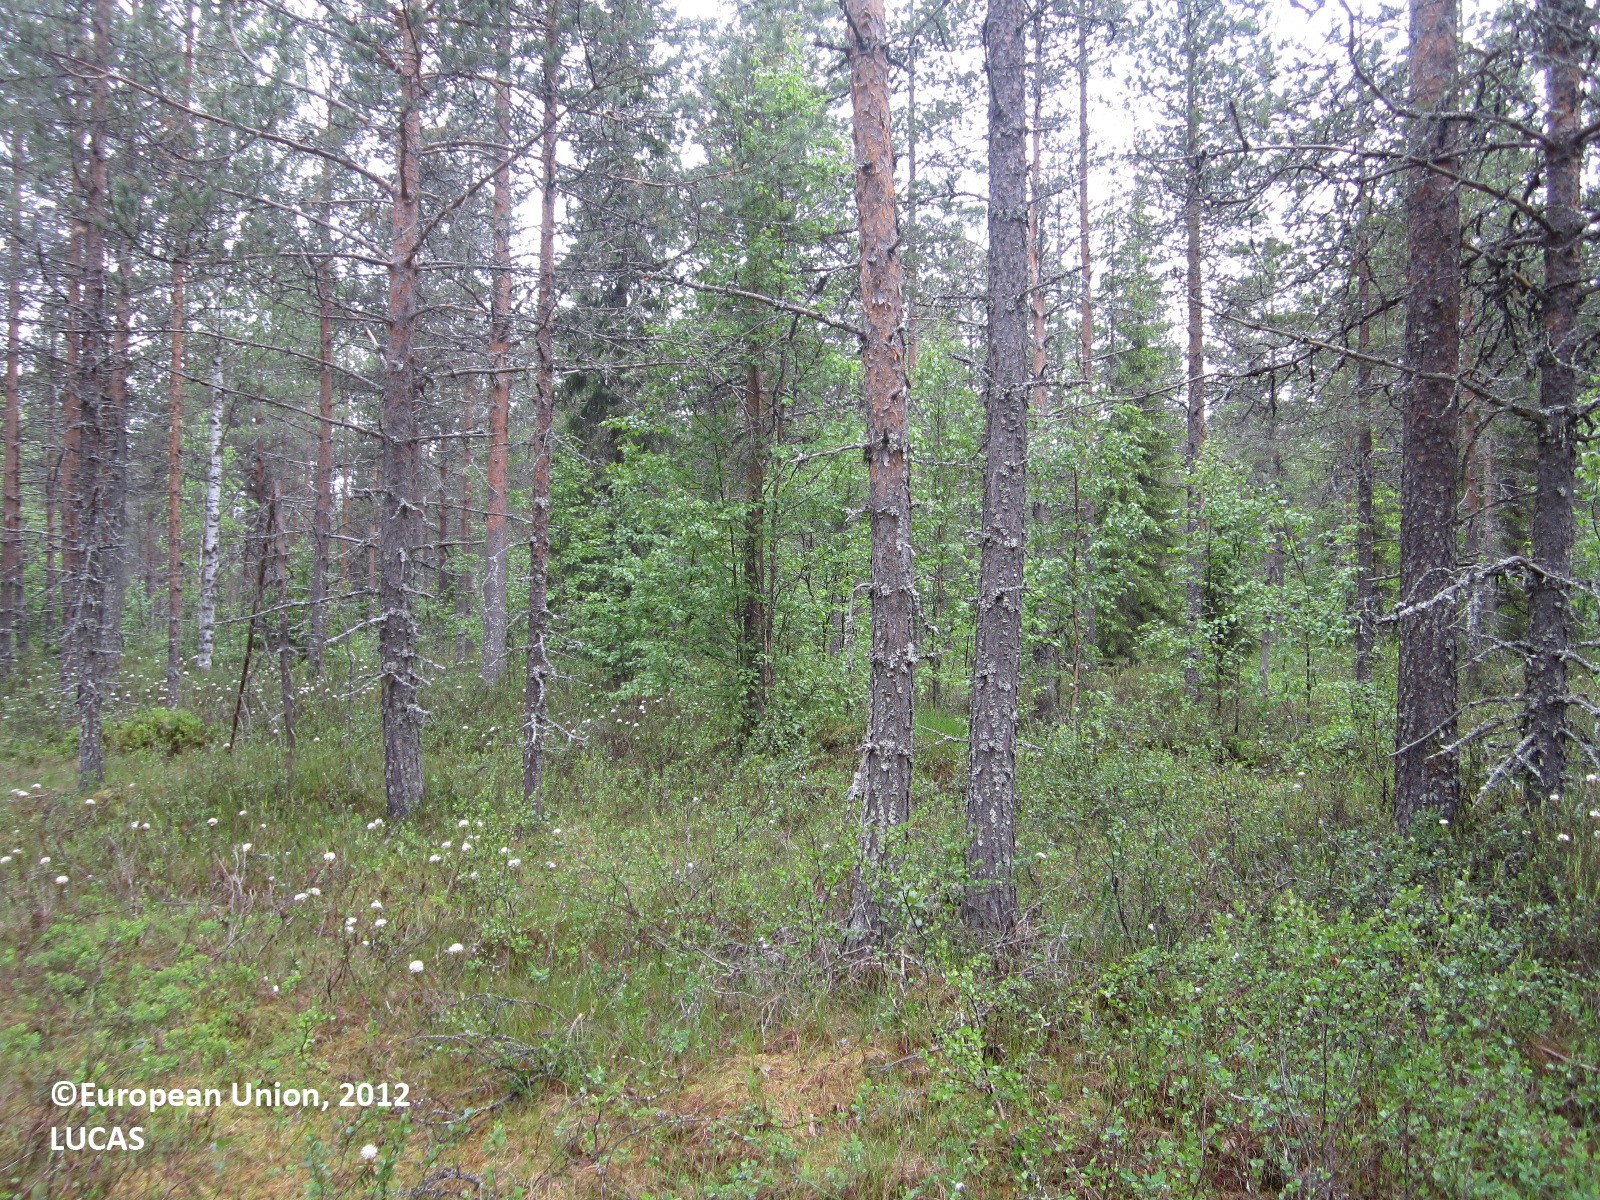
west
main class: Woodland
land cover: Pine dominated coniferous woodland
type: boreal forest
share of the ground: 50 - 75 %
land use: Forestry
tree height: > 5 m
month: June
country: FI
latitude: 64.4410
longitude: 29.2109
